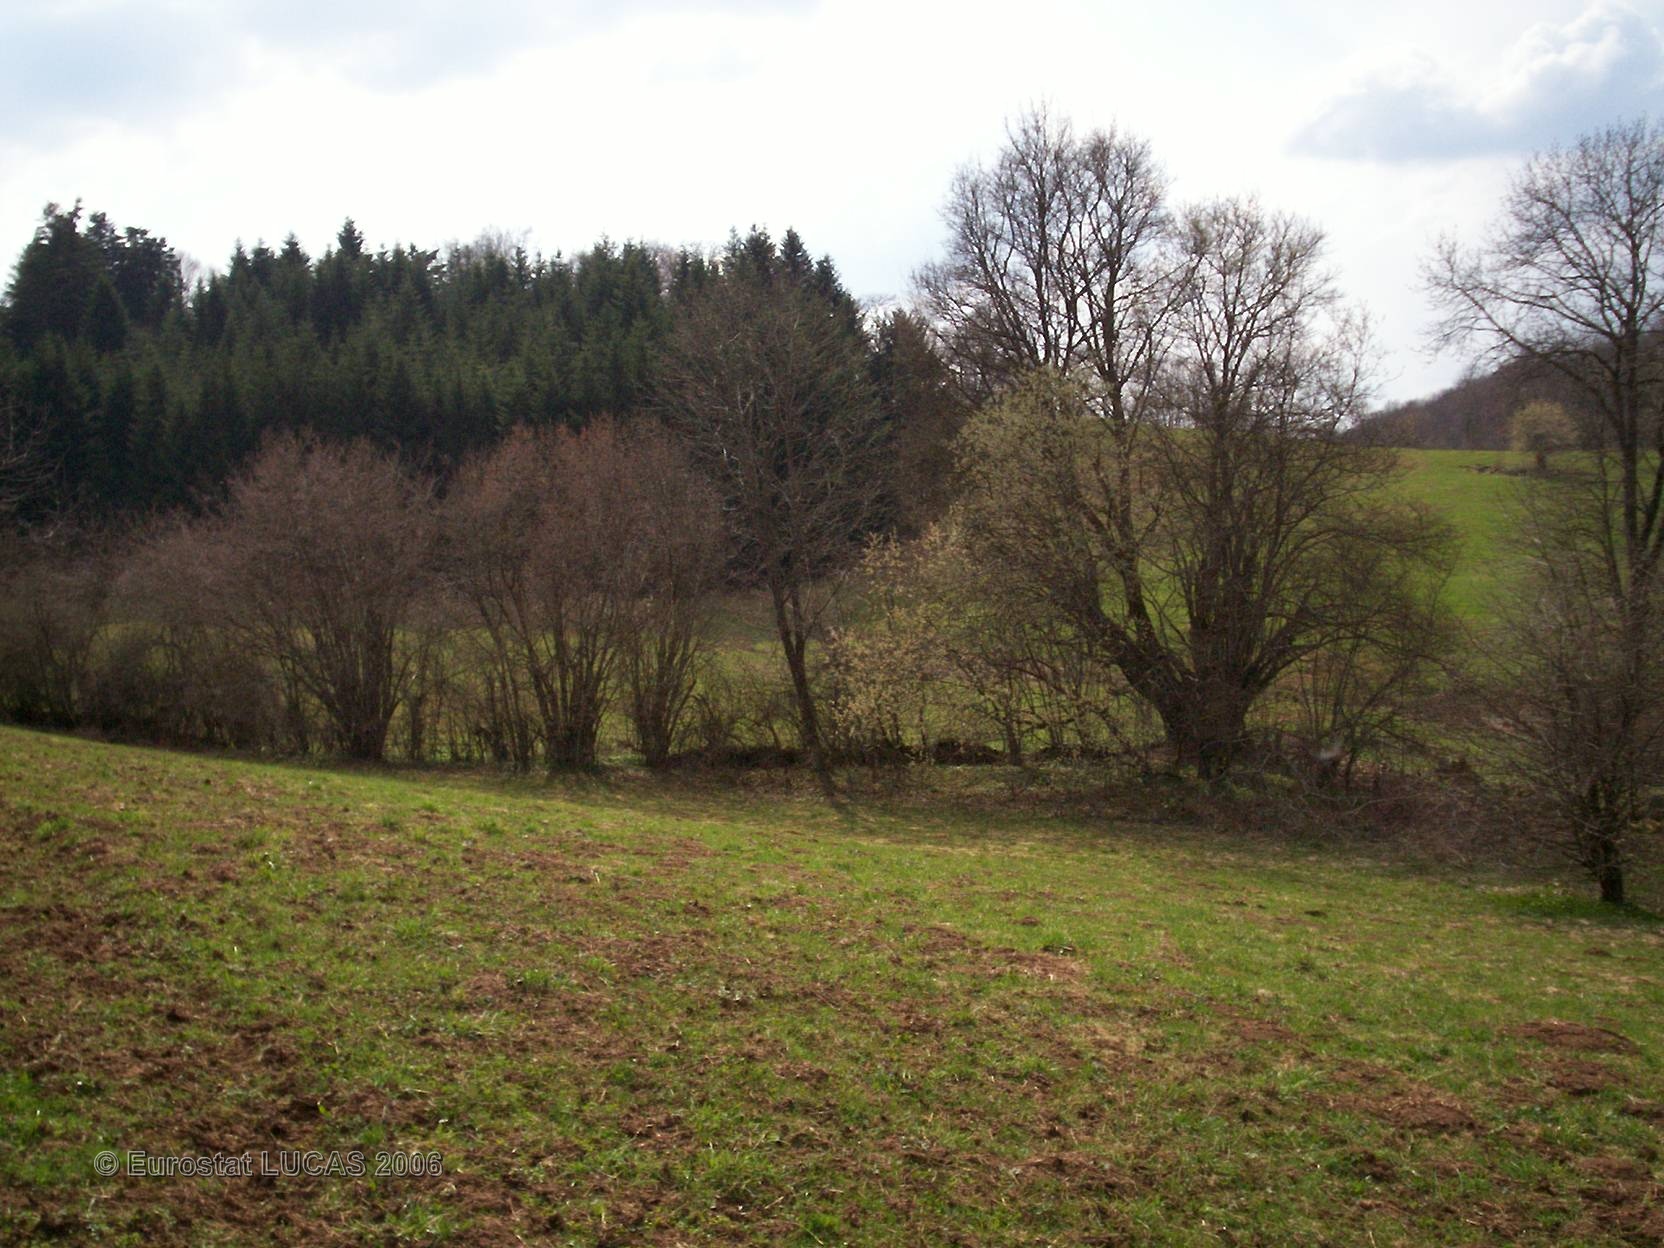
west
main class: Grassland
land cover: Grassland without tree/shrub cover
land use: Agriculture (excluding fallow land and kitchen gardens)
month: April
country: FR
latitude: 47.2714
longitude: 6.6313
